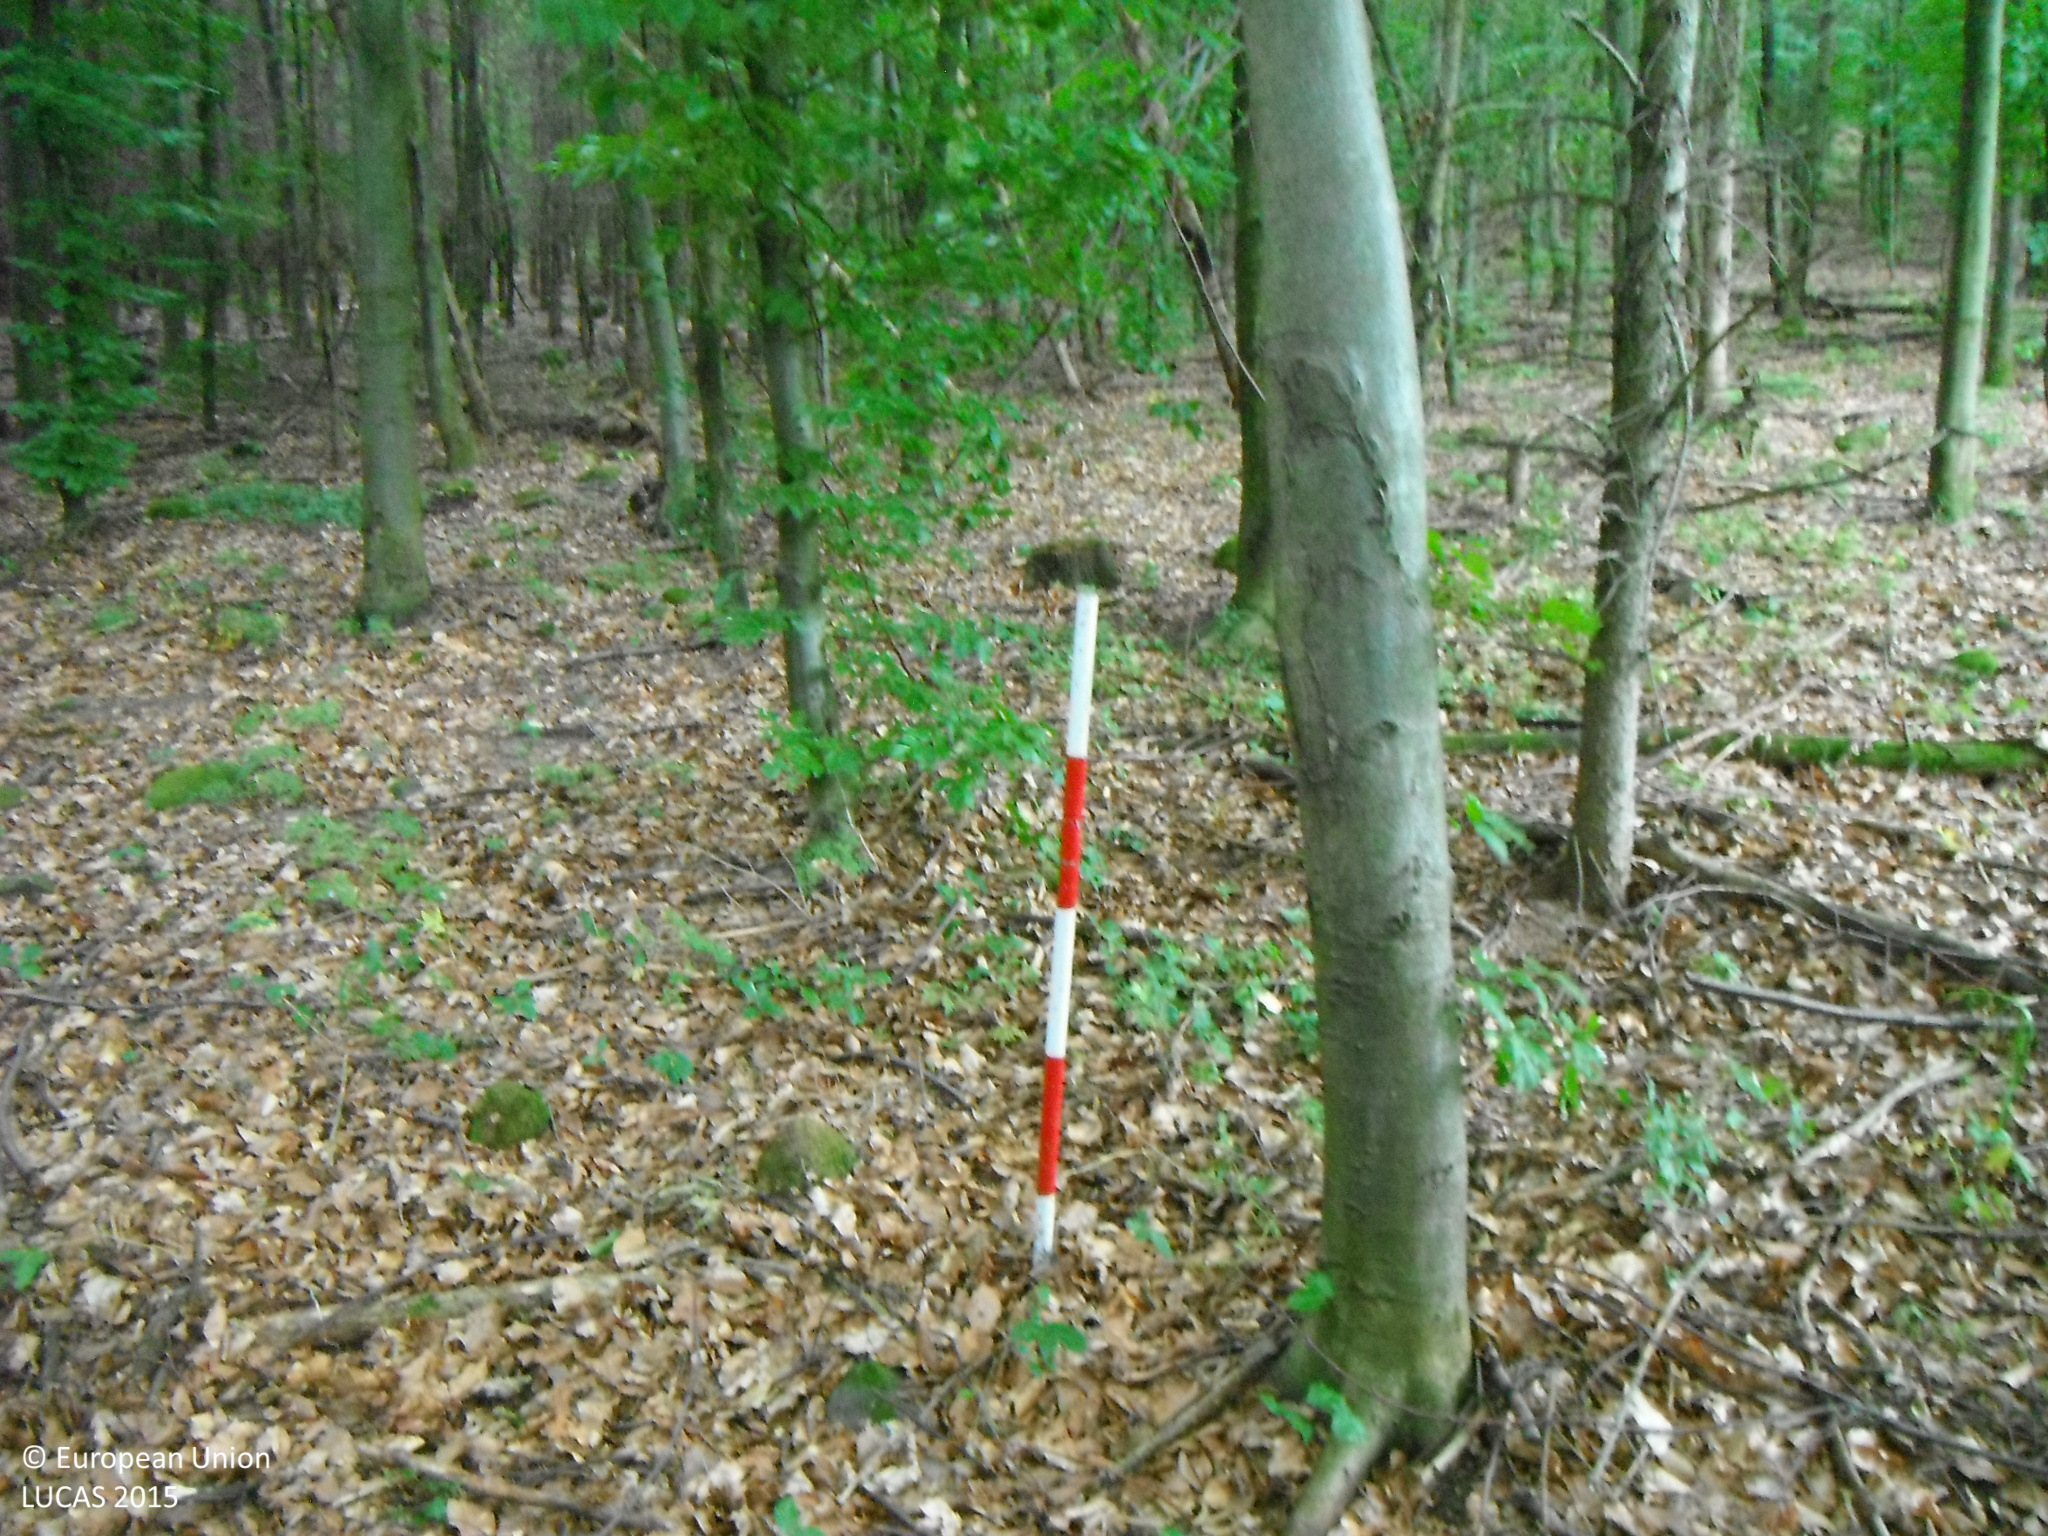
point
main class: Woodland
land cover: Broadleaved woodland
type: beech forest
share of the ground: > 75 %
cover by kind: broadleaved forest trees 80 %, coniferous forest trees 15 %, herbaceous plants 5 %
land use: Forestry
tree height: > 5 m
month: June
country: SK
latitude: 48.3394
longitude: 19.4815
